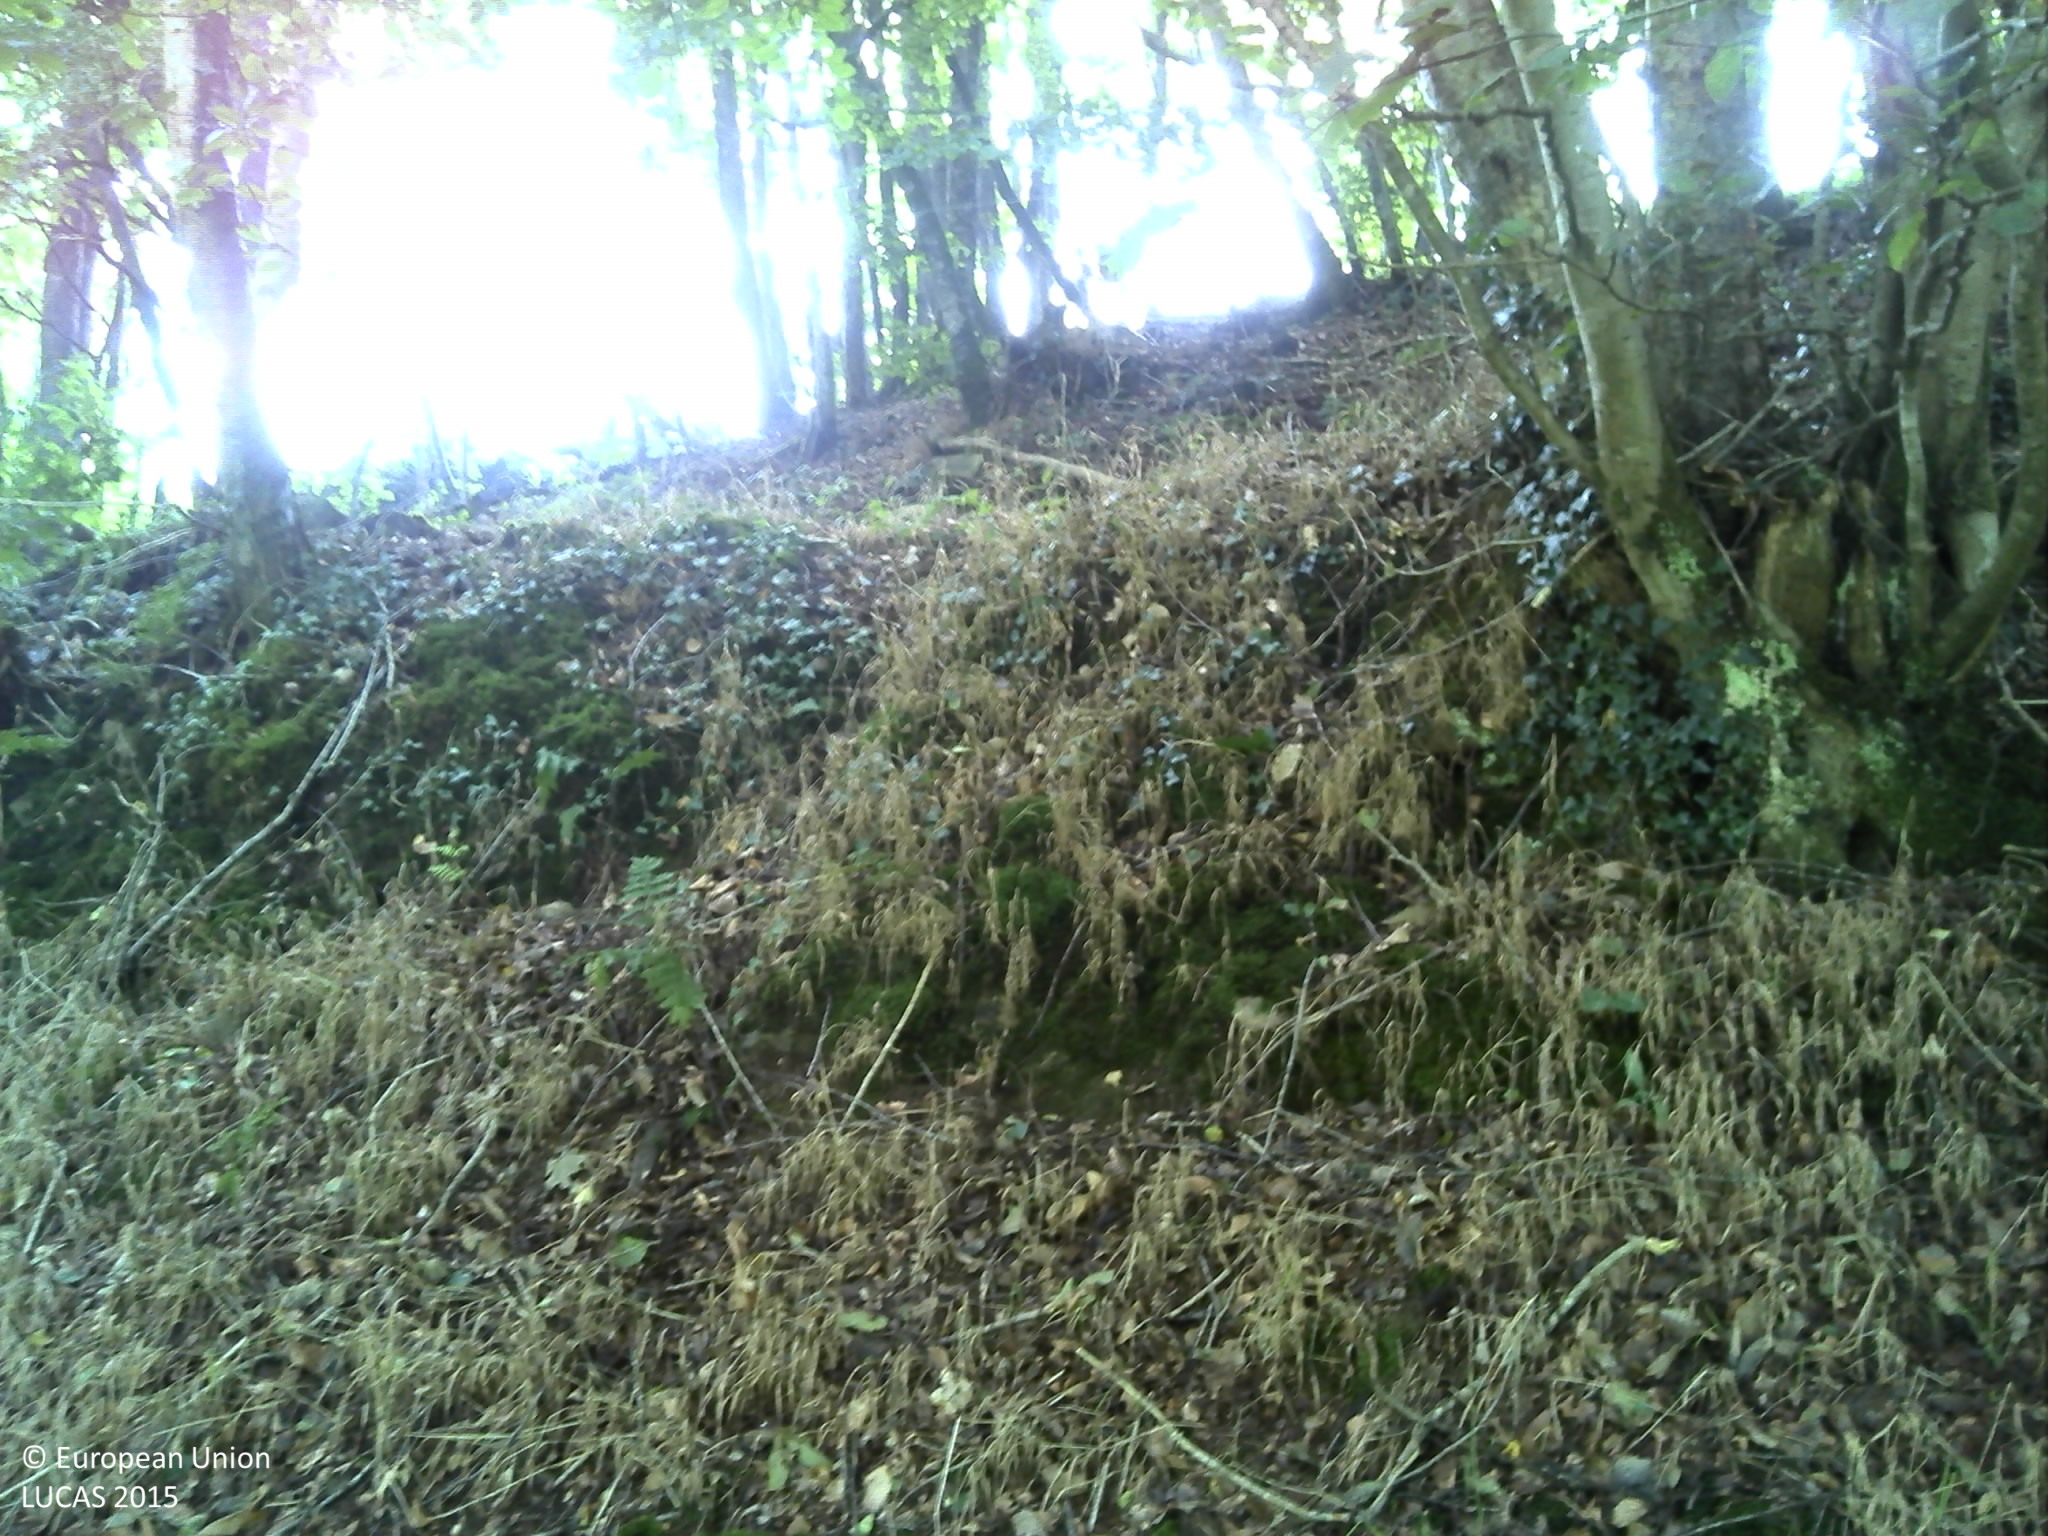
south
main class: Woodland
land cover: Broadleaved woodland
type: beech forest
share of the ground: > 75 %
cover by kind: broadleaved forest trees 100 %
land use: Forestry
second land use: Agriculture (excluding fallow land and kitchen gardens)
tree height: > 5 m
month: August
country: FR
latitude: 48.5698
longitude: -4.2564
